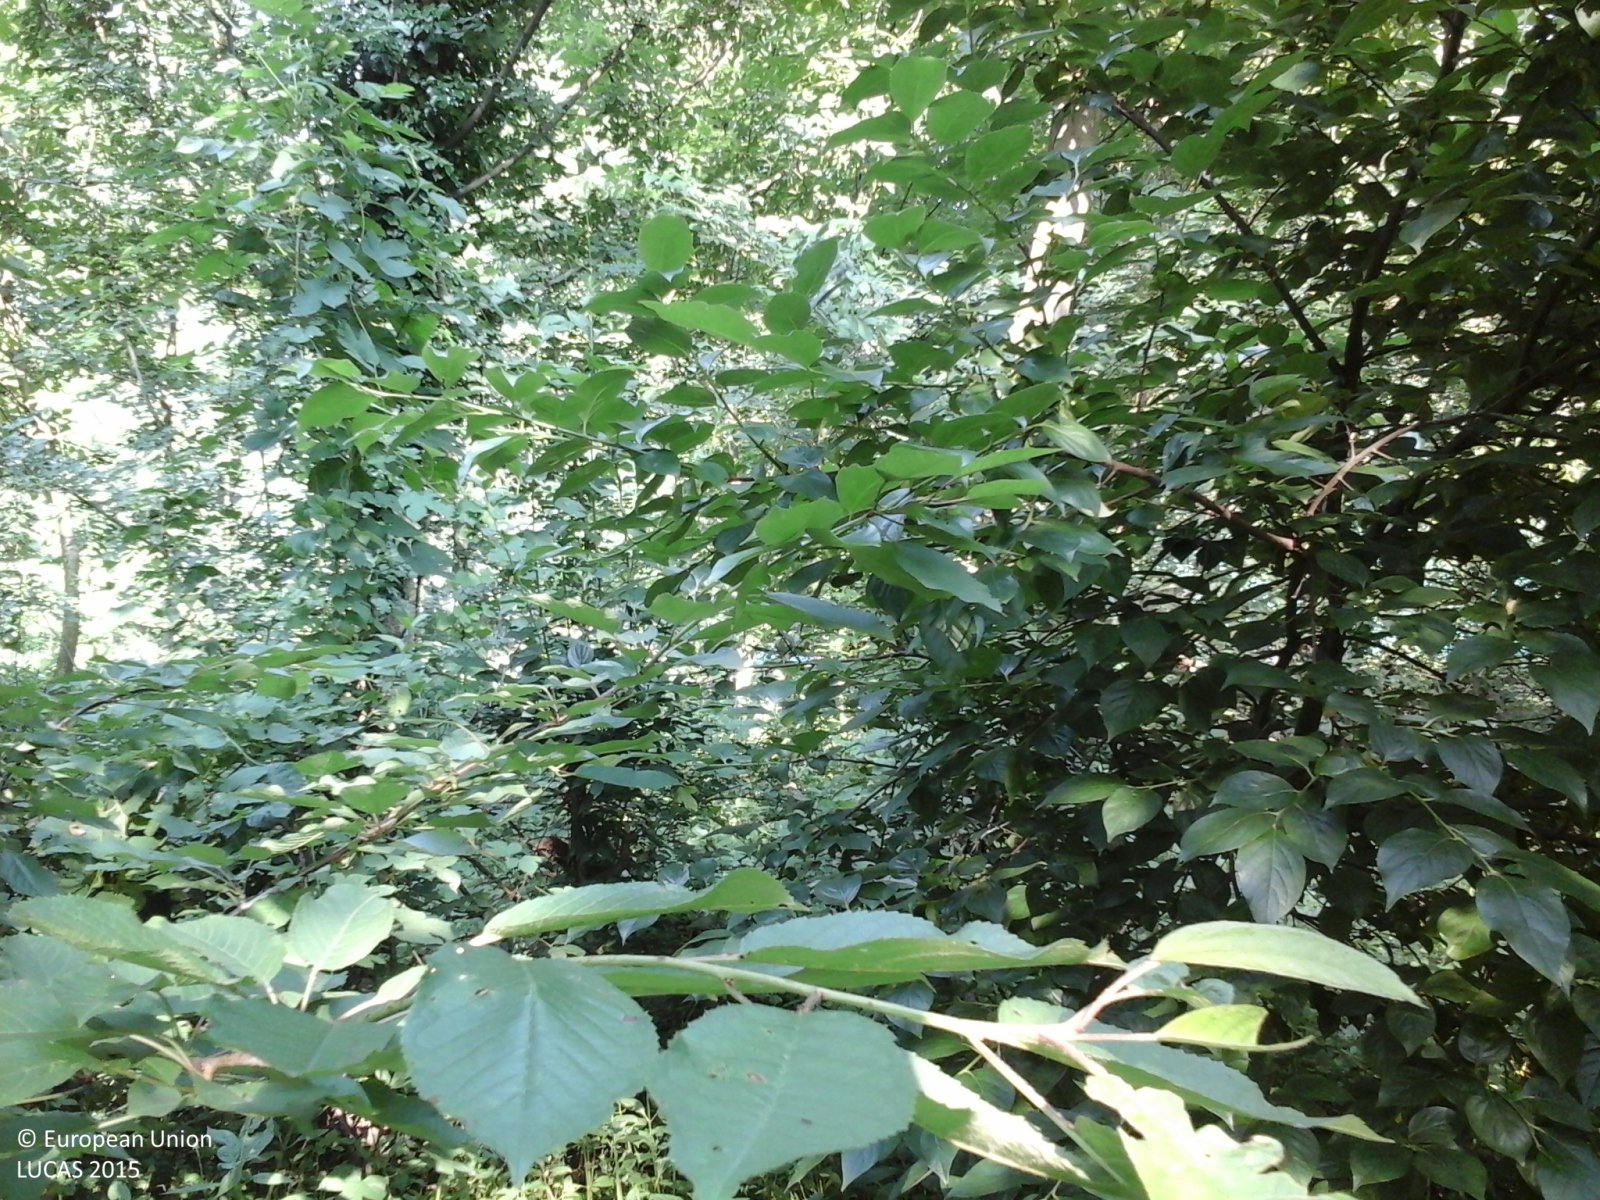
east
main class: Woodland
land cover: Broadleaved woodland
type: thermophilous deciduous forest
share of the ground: > 75 %
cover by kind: broadleaved forest trees 100 %
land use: Forestry
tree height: > 5 m
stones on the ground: < 10 %
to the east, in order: Broadleaved woodland; Grassland without tree/shrub cover; Paved roads, cycling and walking lanes; Broadleaved woodland; Artificial constructions in urban areas; Broadleaved woodland; Other fresh vegetables; Managed hedges; Railways
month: June
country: IT
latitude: 45.9791
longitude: 8.4146
